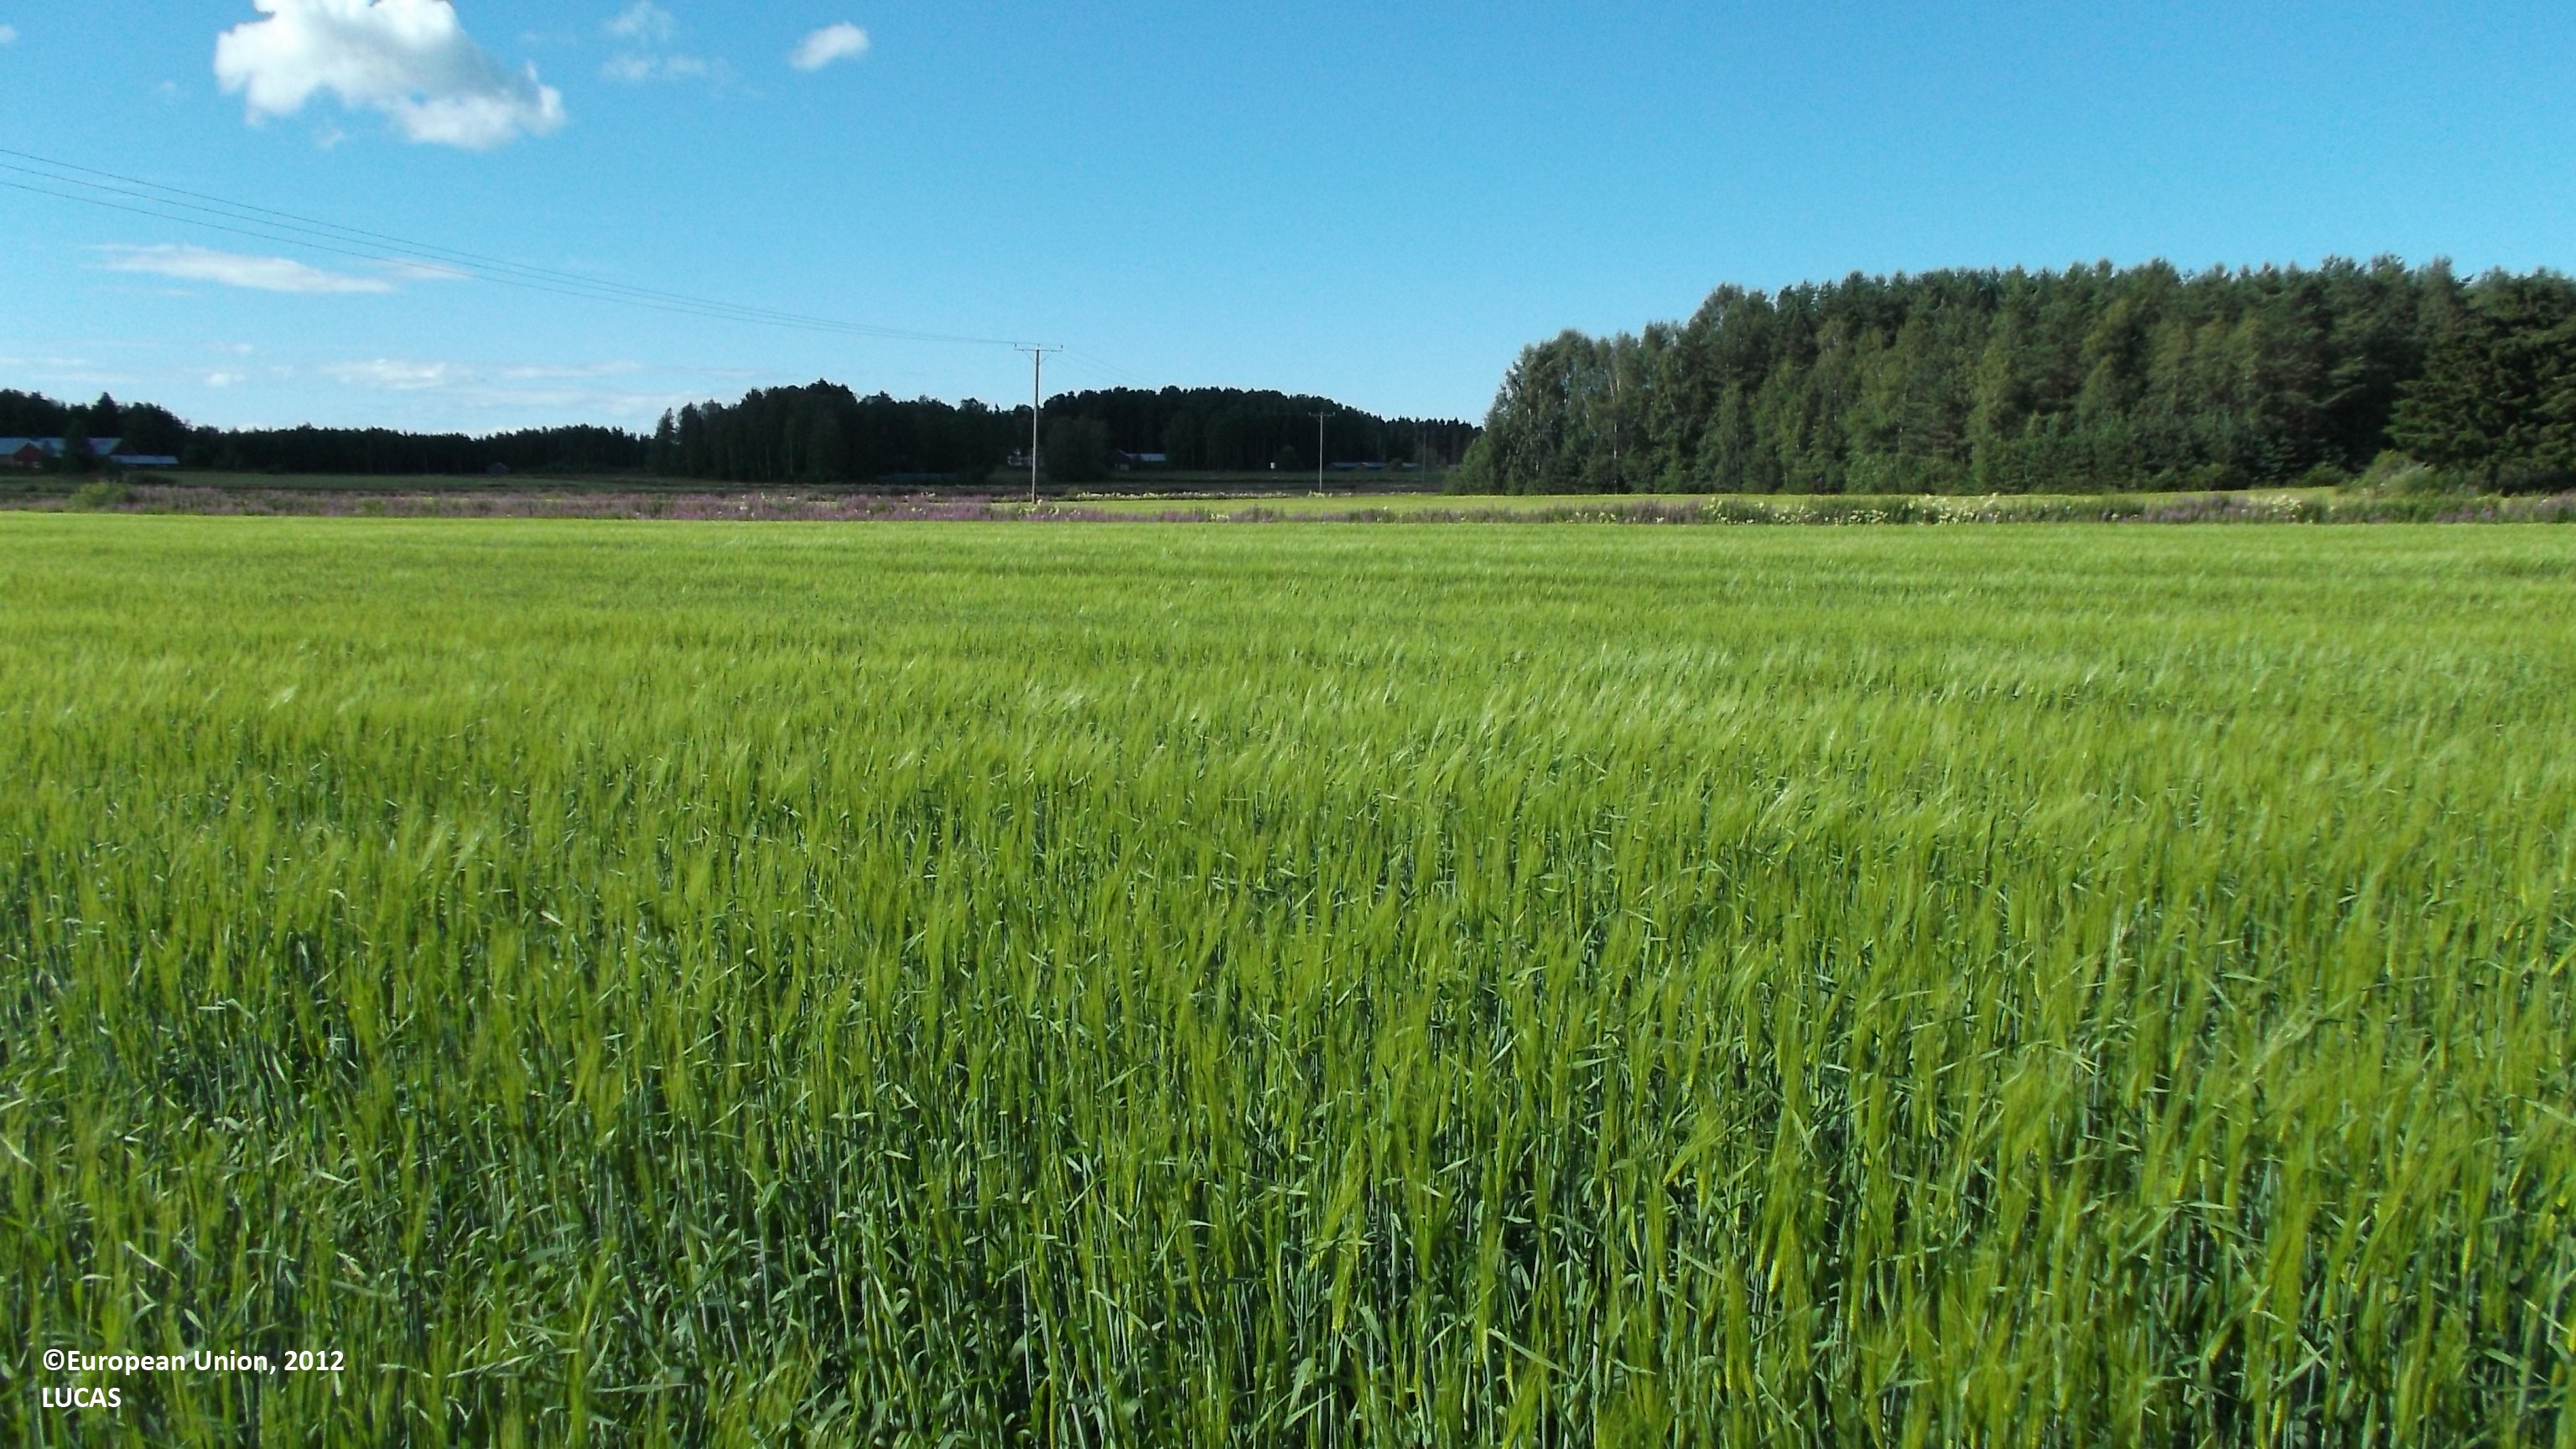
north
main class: Cropland
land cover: Barley
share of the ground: > 75 %
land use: Agriculture (excluding fallow land and kitchen gardens)
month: July
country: FI
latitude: 63.5771
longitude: 22.8823
